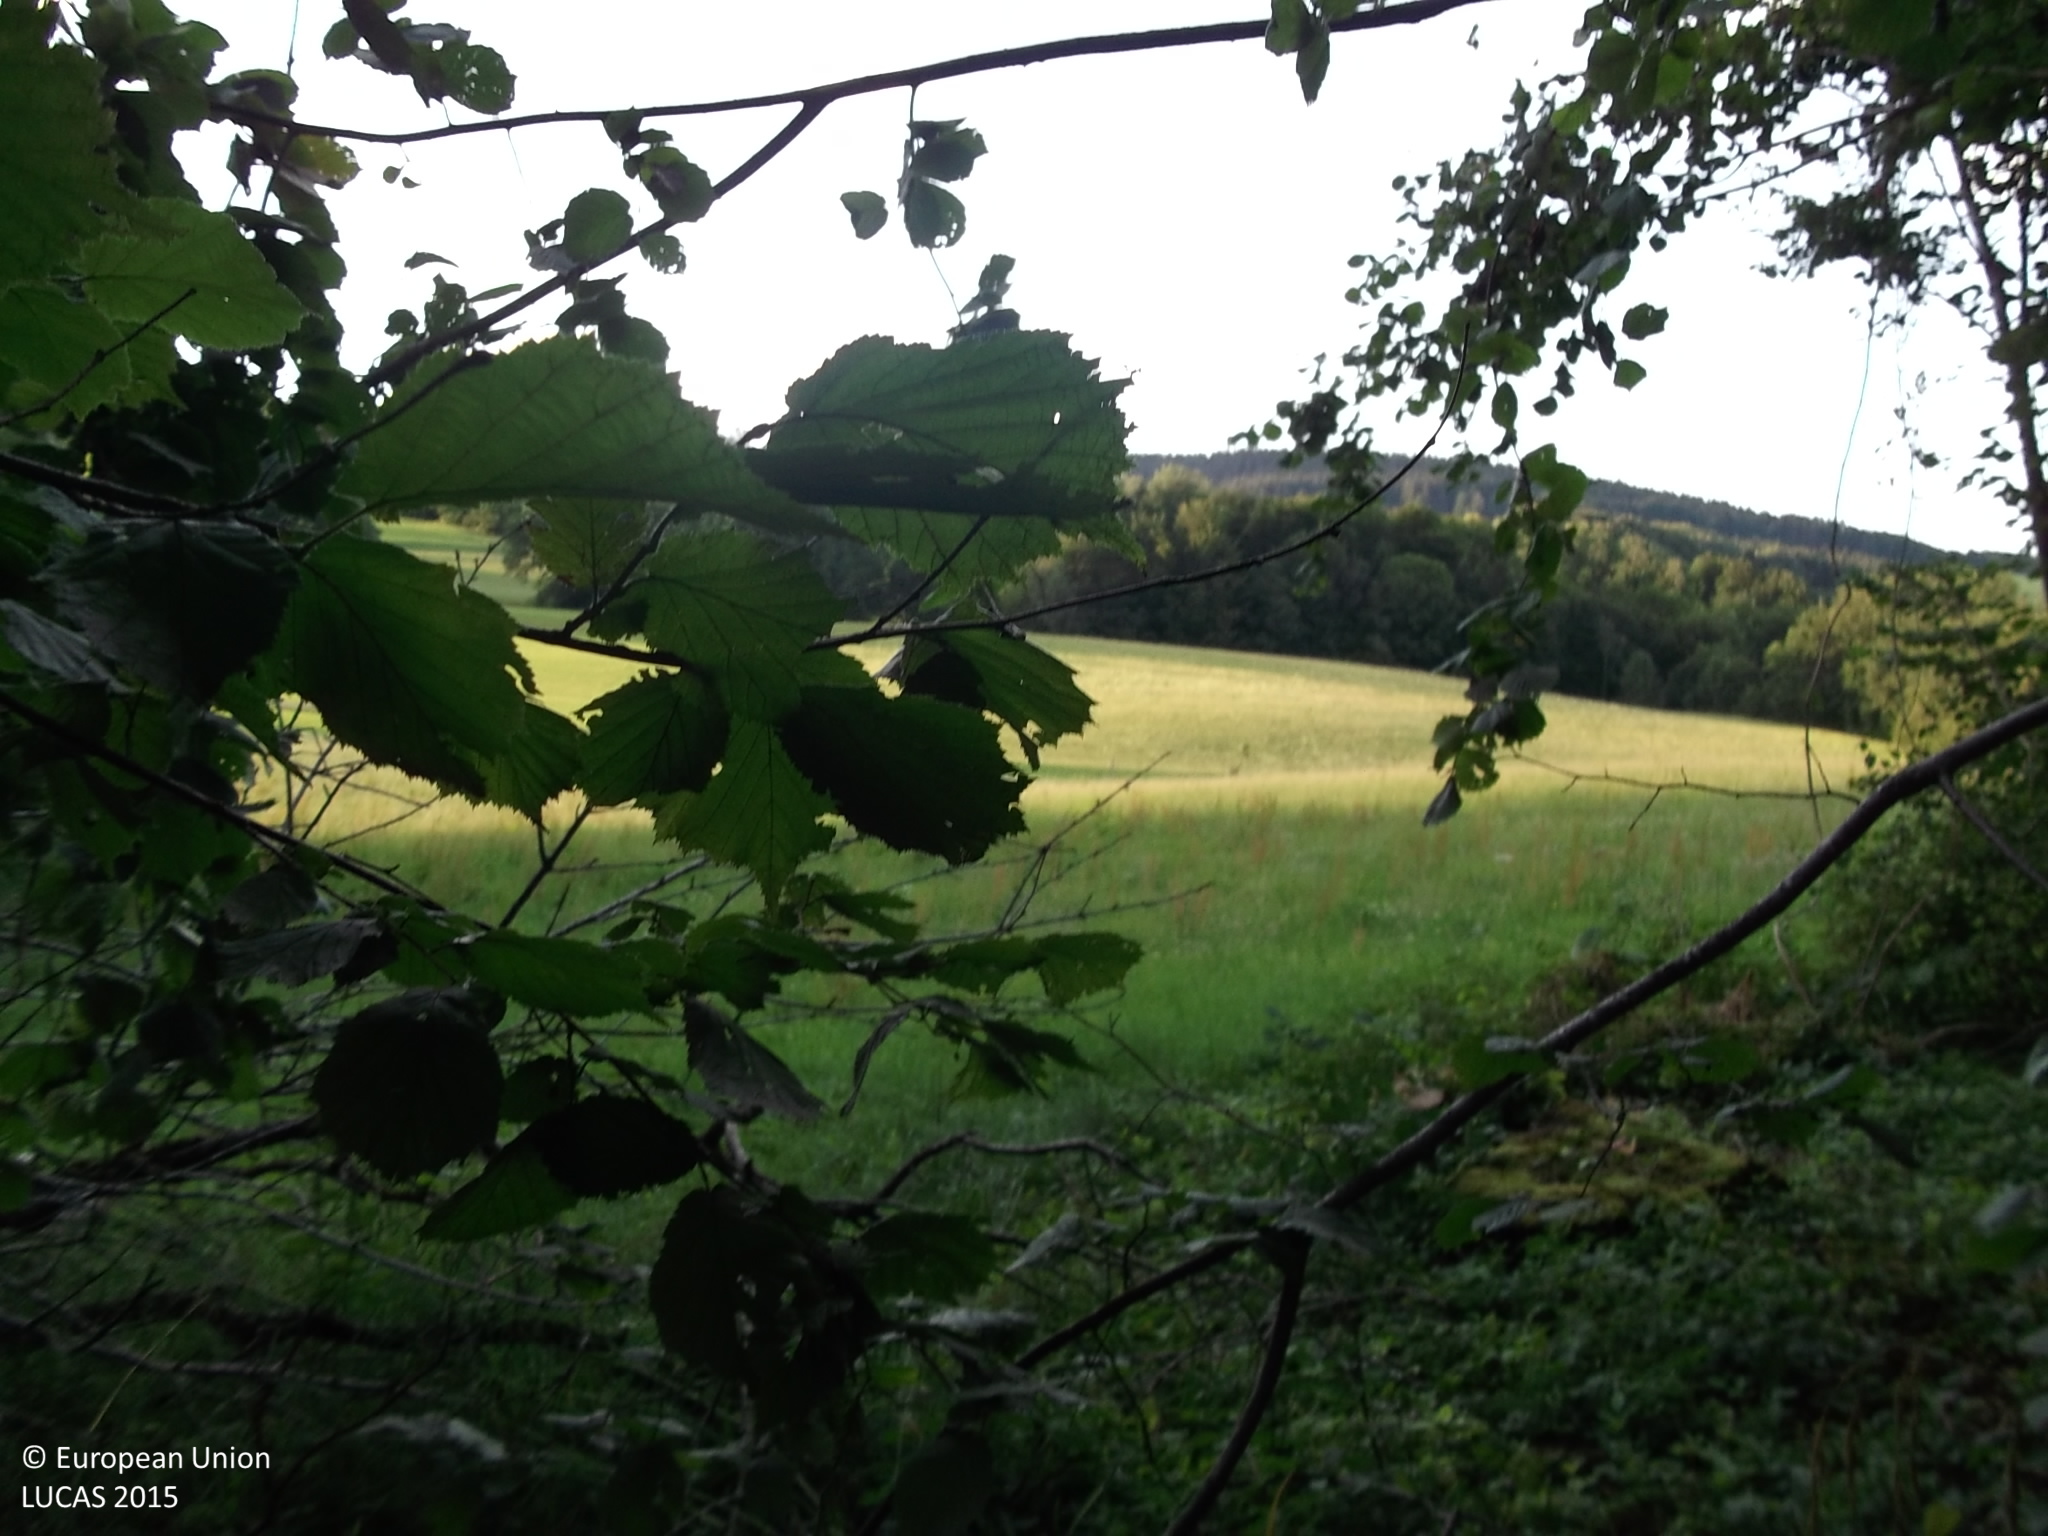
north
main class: Woodland
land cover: Broadleaved woodland
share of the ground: > 75 %
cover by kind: broadleaved forest trees 80 %, coniferous forest trees 10 %, shrubs 5 %, herbaceous plants 5 %
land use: Forestry
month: July
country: AT
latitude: 47.9211
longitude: 13.3310
